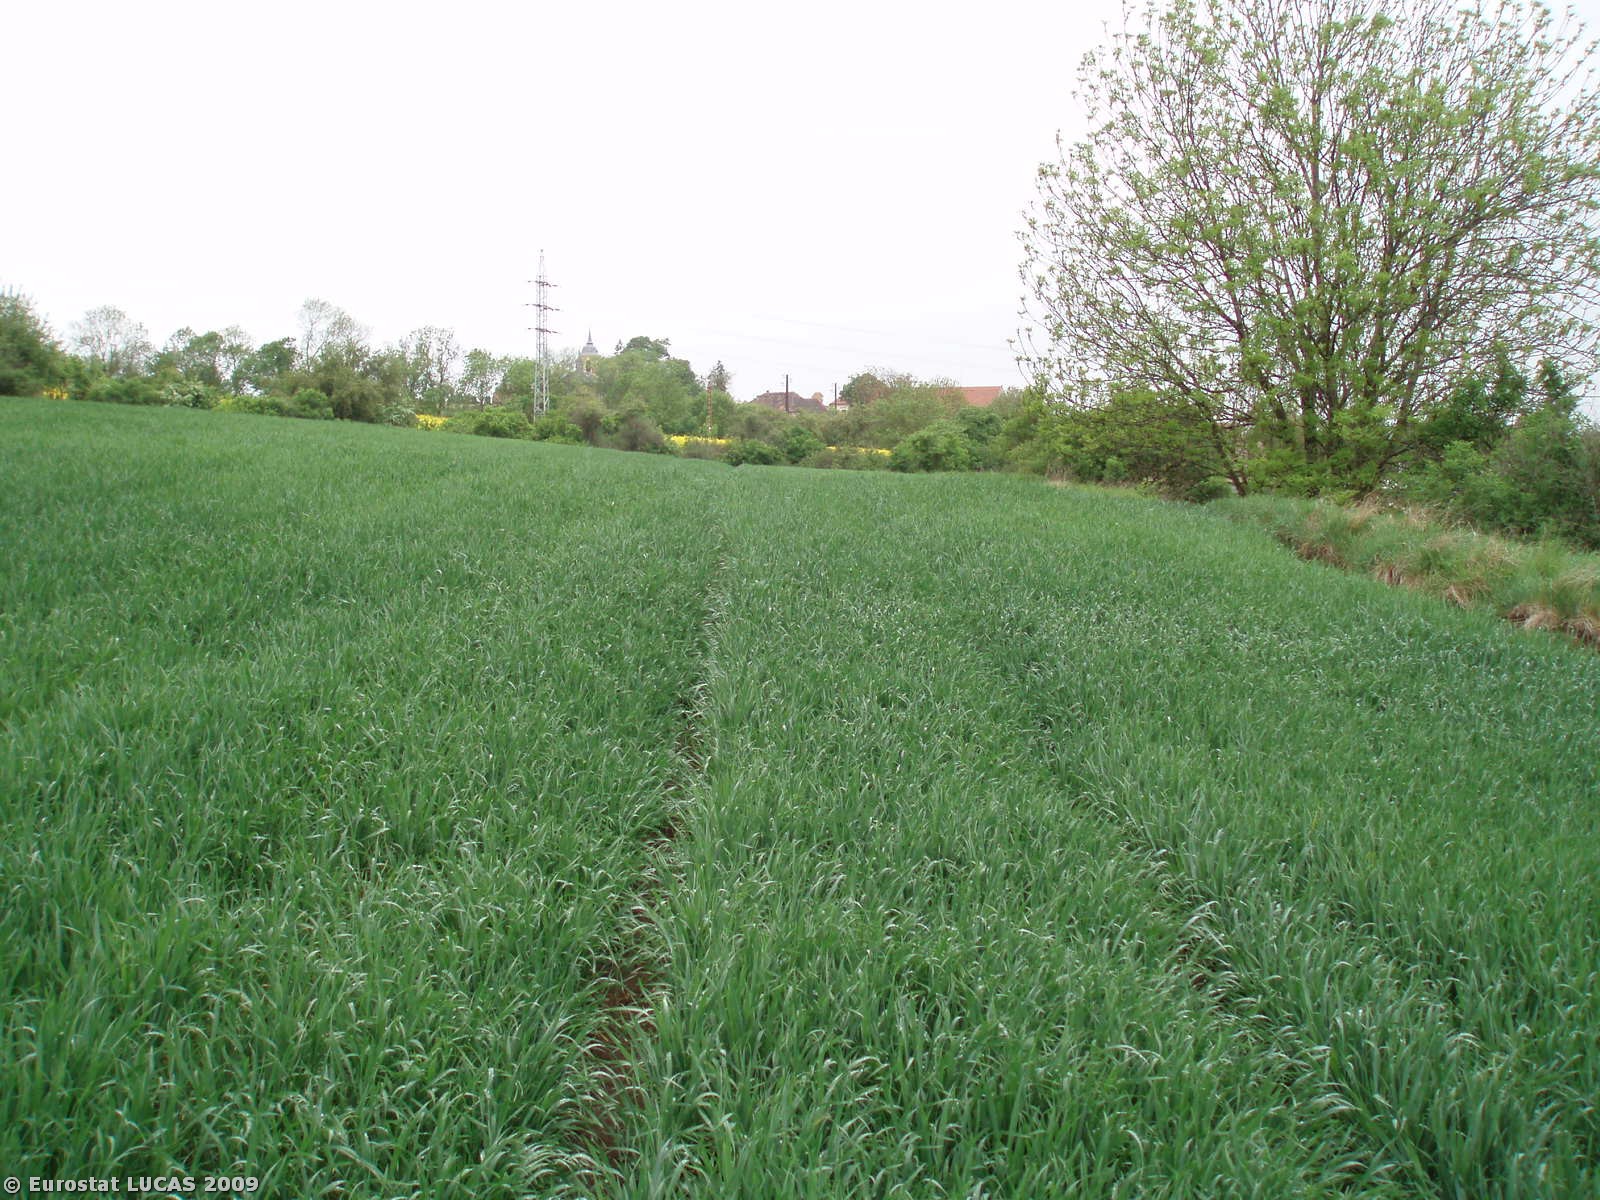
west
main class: Cropland
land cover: Common wheat
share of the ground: > 75 %
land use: Agriculture (excluding fallow land and kitchen gardens)
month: May
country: CZ
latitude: 50.2701
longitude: 14.1681
